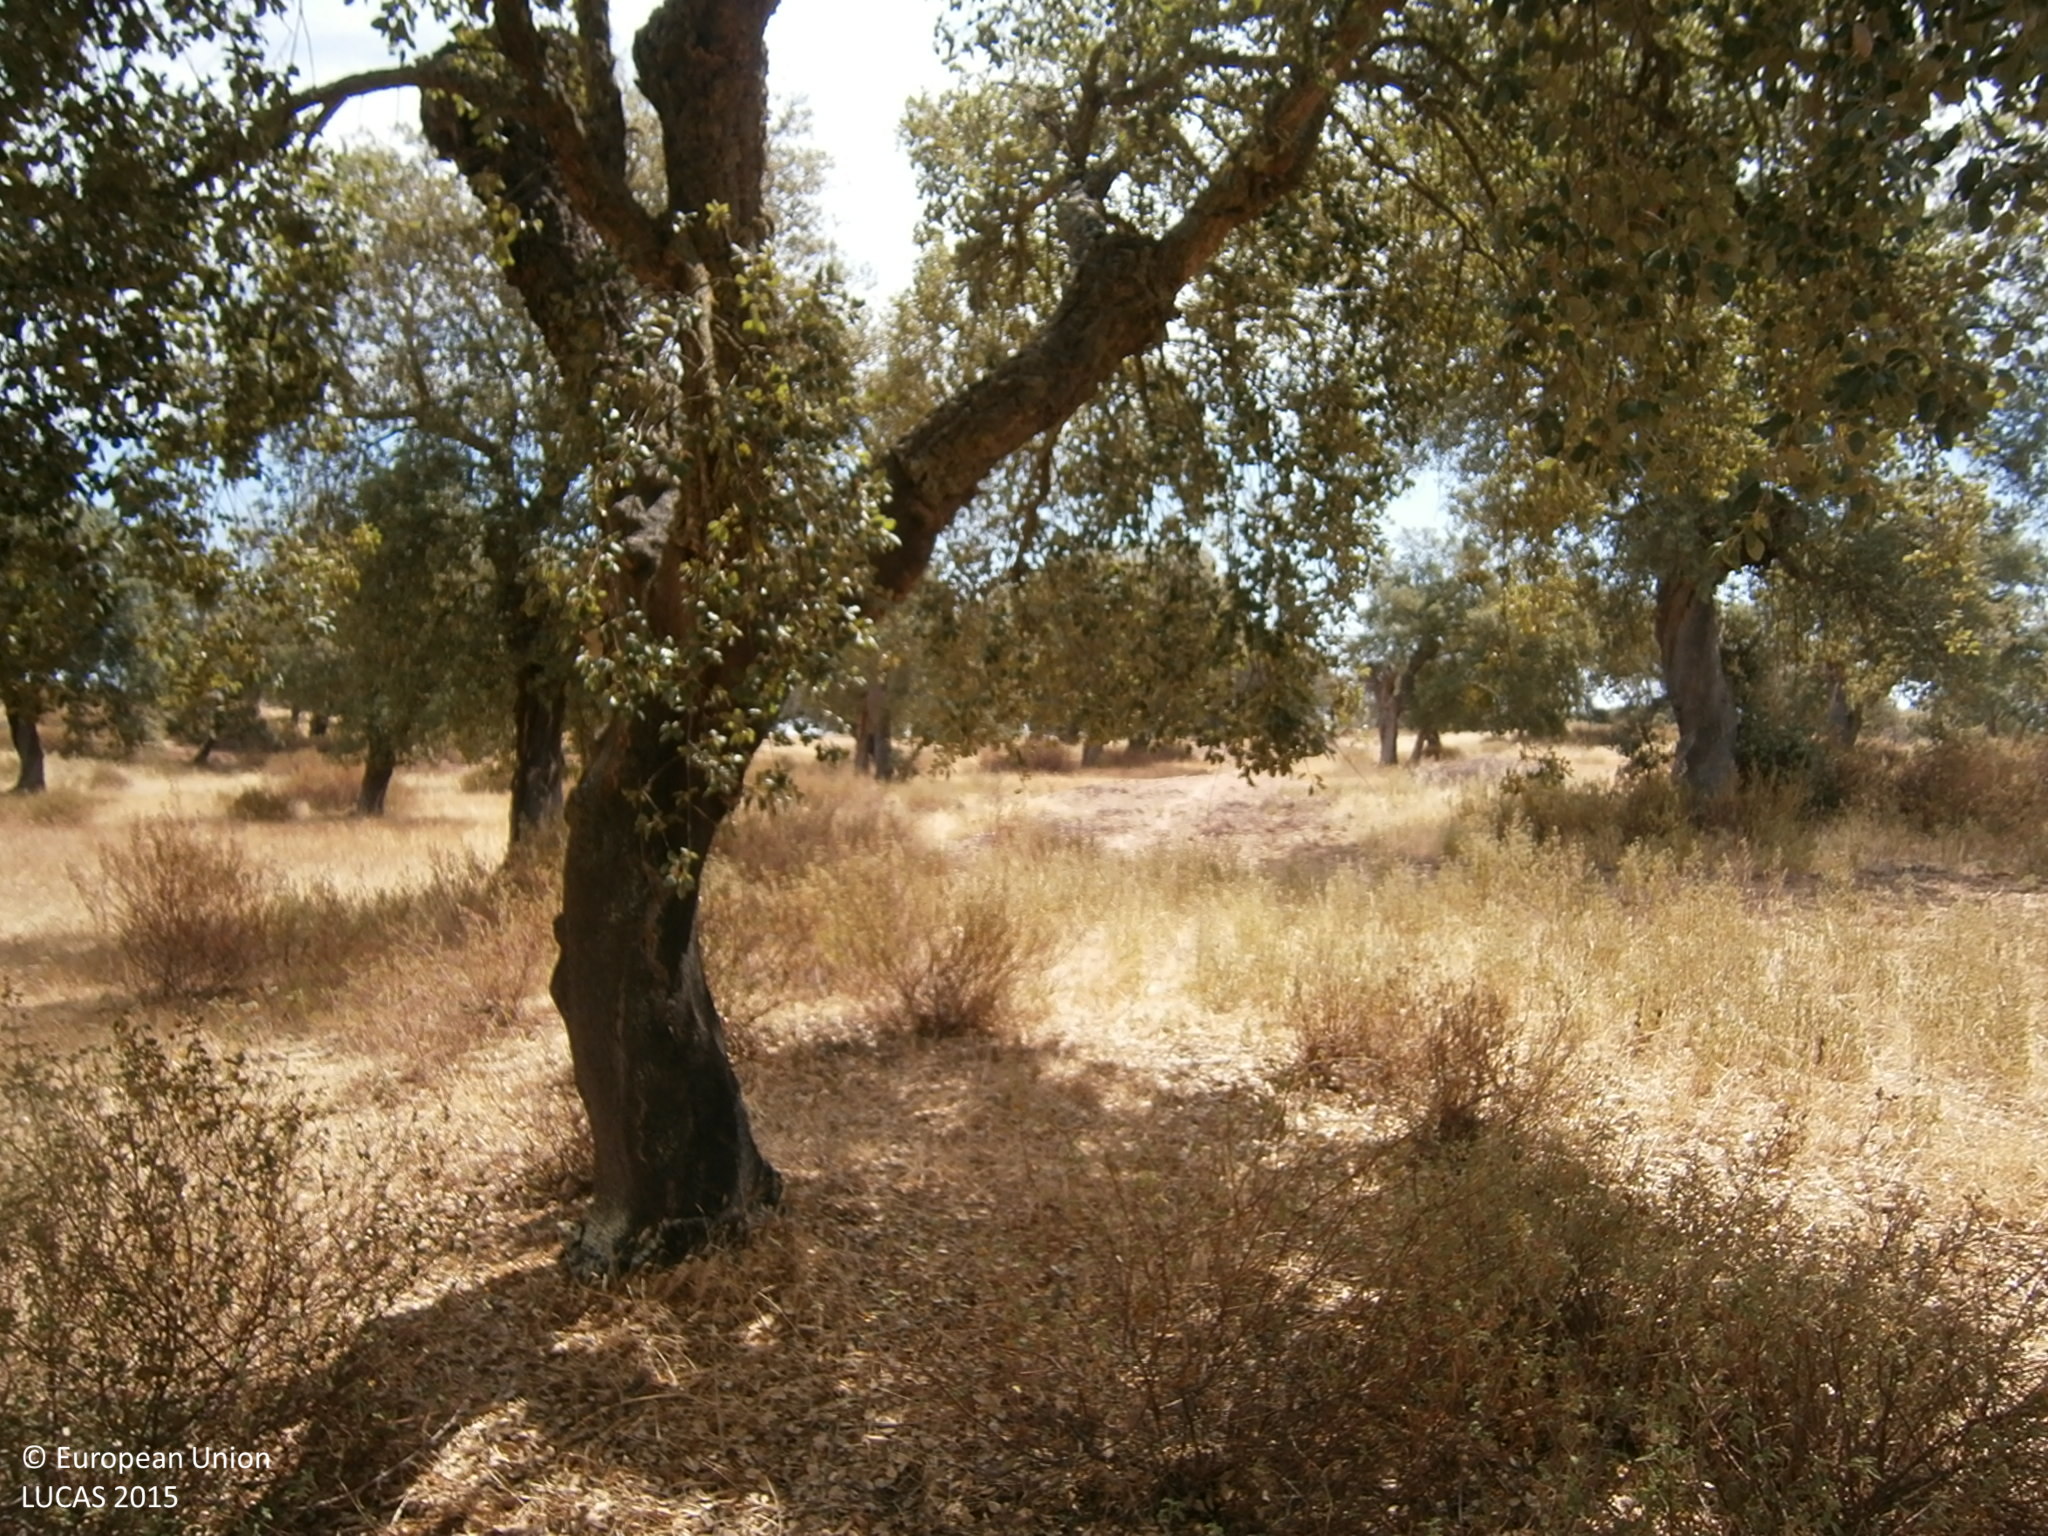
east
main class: Woodland
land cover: Broadleaved woodland
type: broadleaved evergreen forest
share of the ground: > 75 %
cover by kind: herbaceous plants 60 %, broadleaved forest trees 30 %, shrubs 10 %
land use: Forestry
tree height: > 5 m
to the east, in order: Broadleaved woodland; Shrubland with sparse tree cover
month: July
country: ES
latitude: 38.7931
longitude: -6.9814
